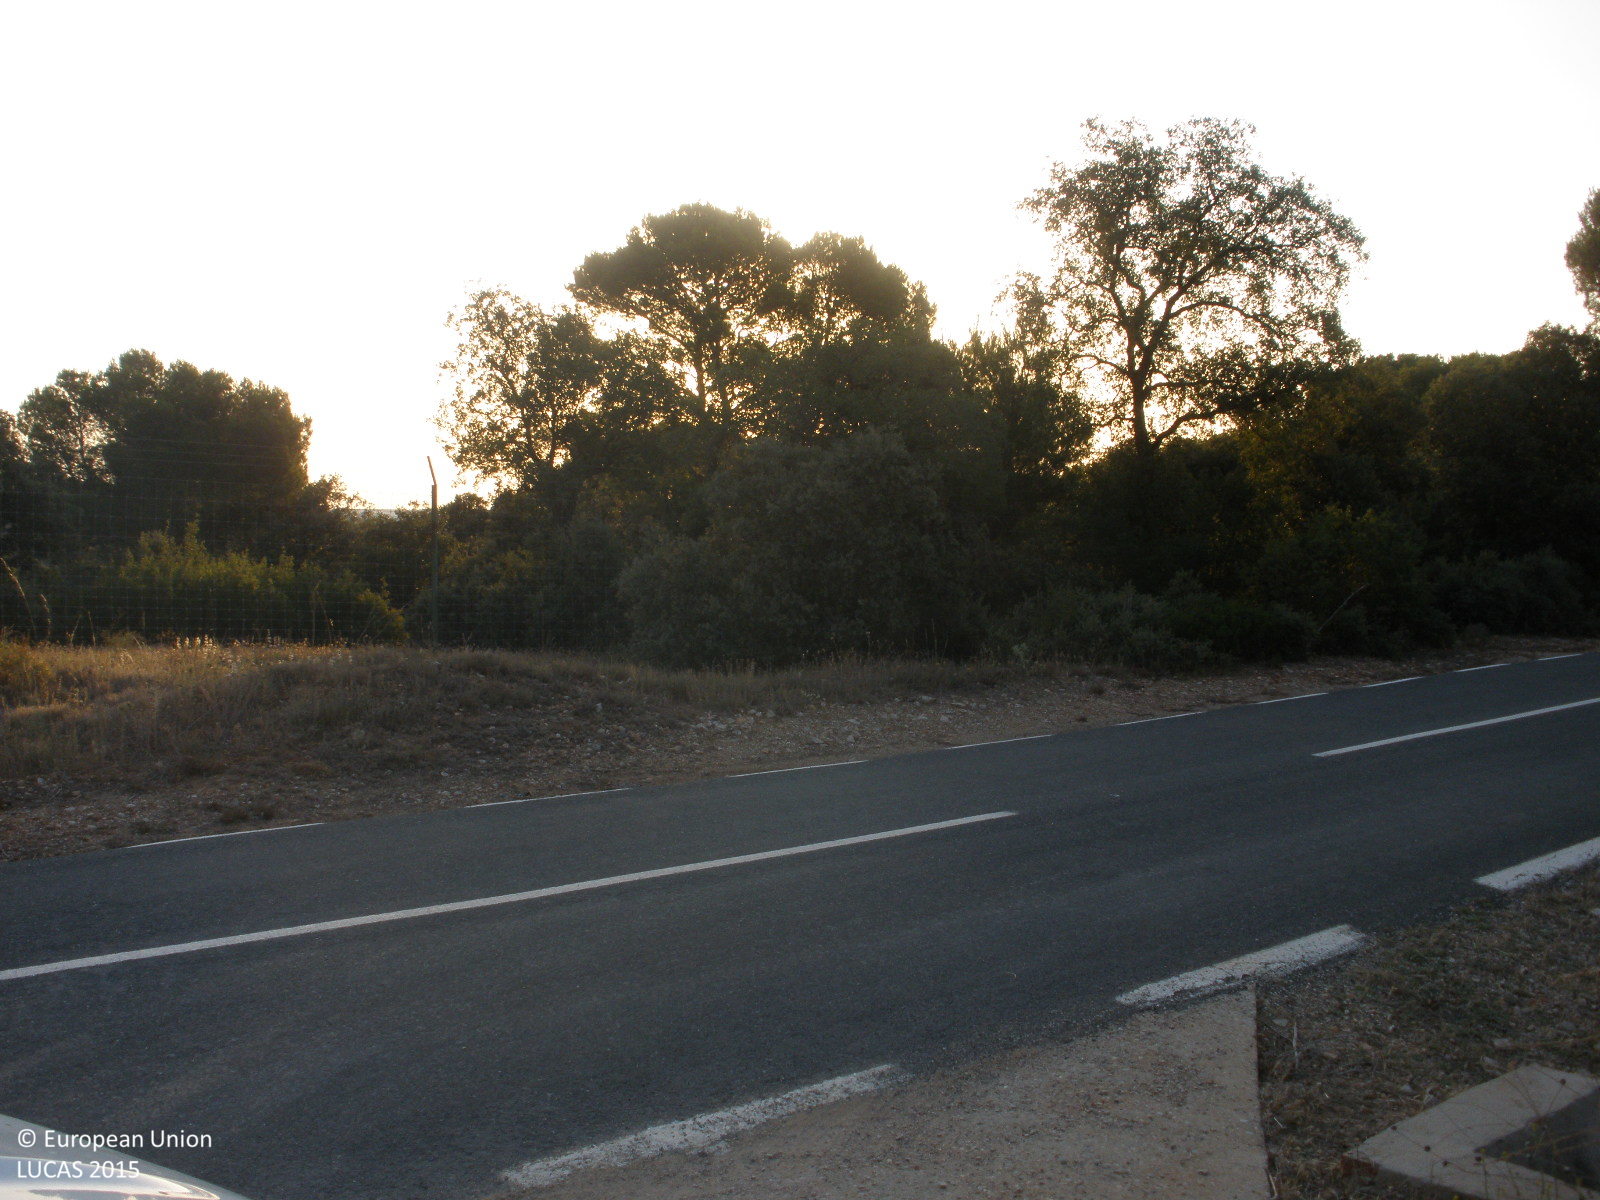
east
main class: Woodland
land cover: Pine dominated coniferous woodland
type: coniferous forest of the mediterranean region
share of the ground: 50 - 75 %
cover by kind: coniferous forest trees 50 %, herbaceous plants 30 %, unconsolidated bare surface 20 %
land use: Semi-natural and natural areas not in use
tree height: > 5 m
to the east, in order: Pine dominated coniferous woodland
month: June
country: ES
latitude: 40.0843
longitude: -3.3395
